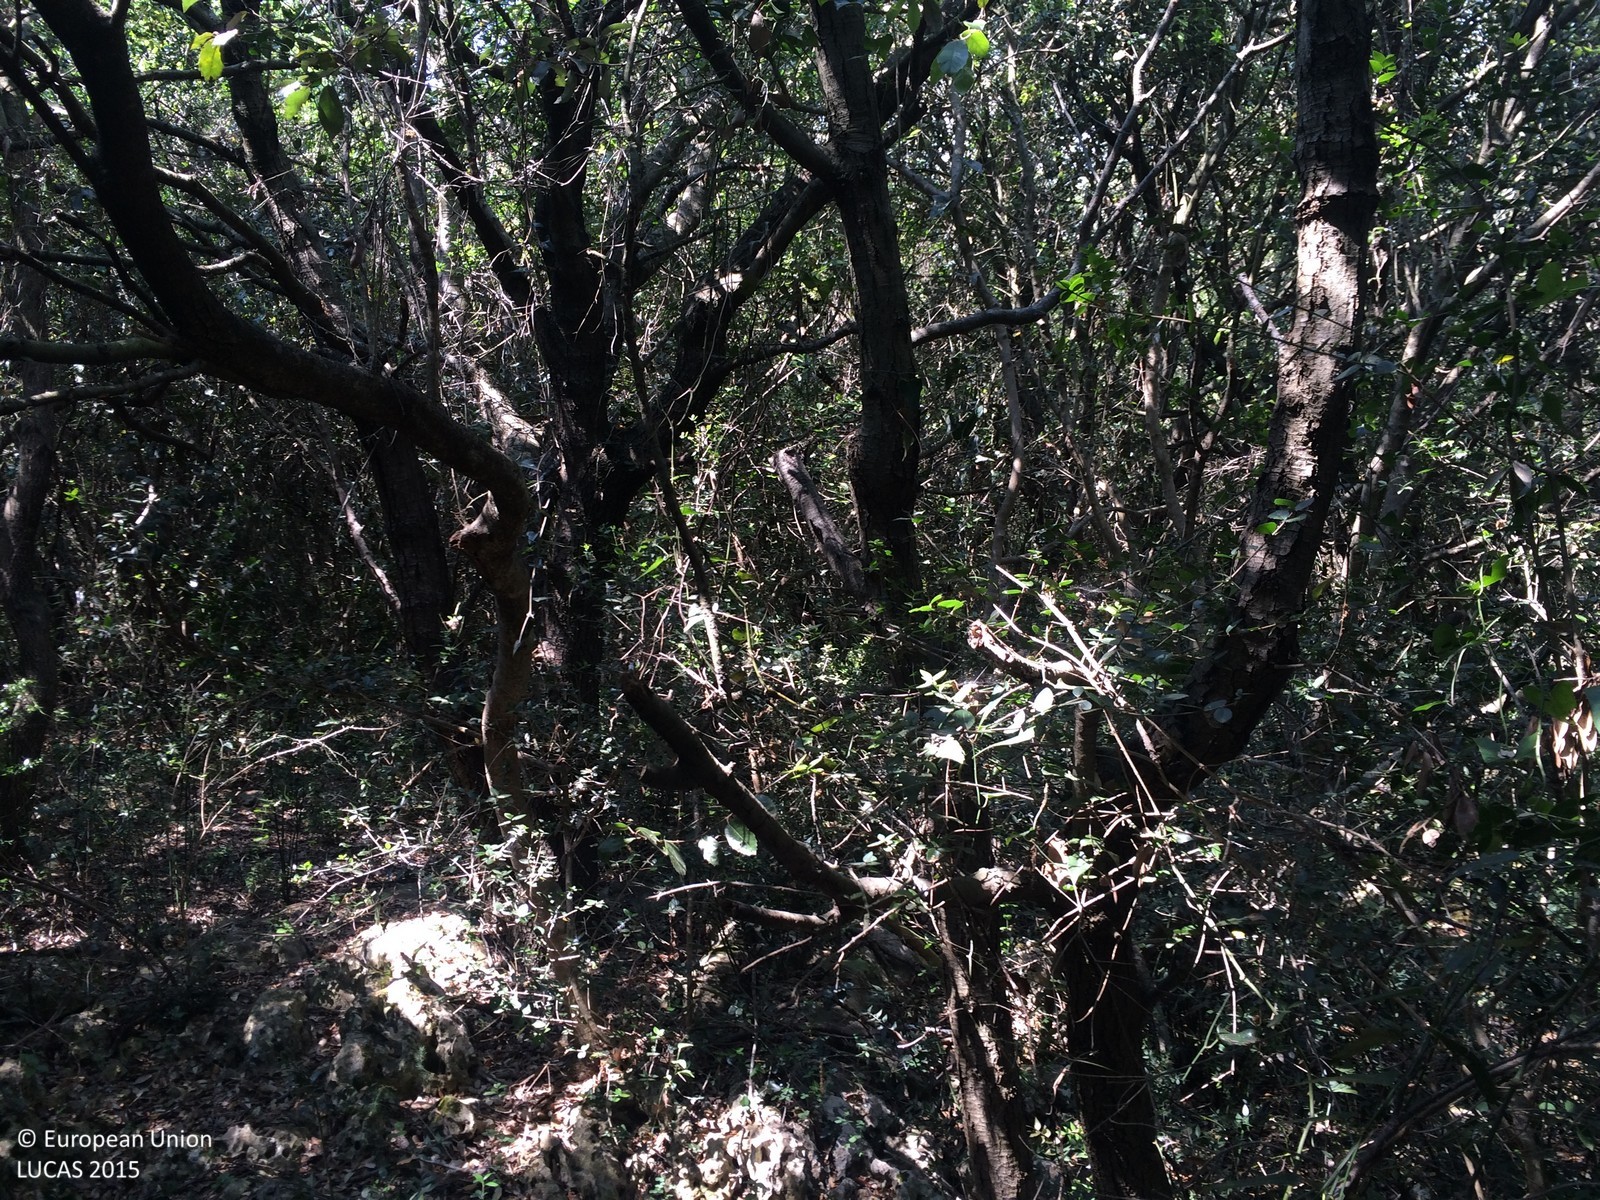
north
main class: Woodland
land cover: Broadleaved woodland
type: broadleaved evergreen forest
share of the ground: > 75 %
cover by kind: broadleaved forest trees 90 %, coniferous forest trees 5 %, shrubs 5 %
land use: Semi-natural and natural areas not in use
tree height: > 5 m
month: June
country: HR
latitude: 44.8387
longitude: 13.8524
